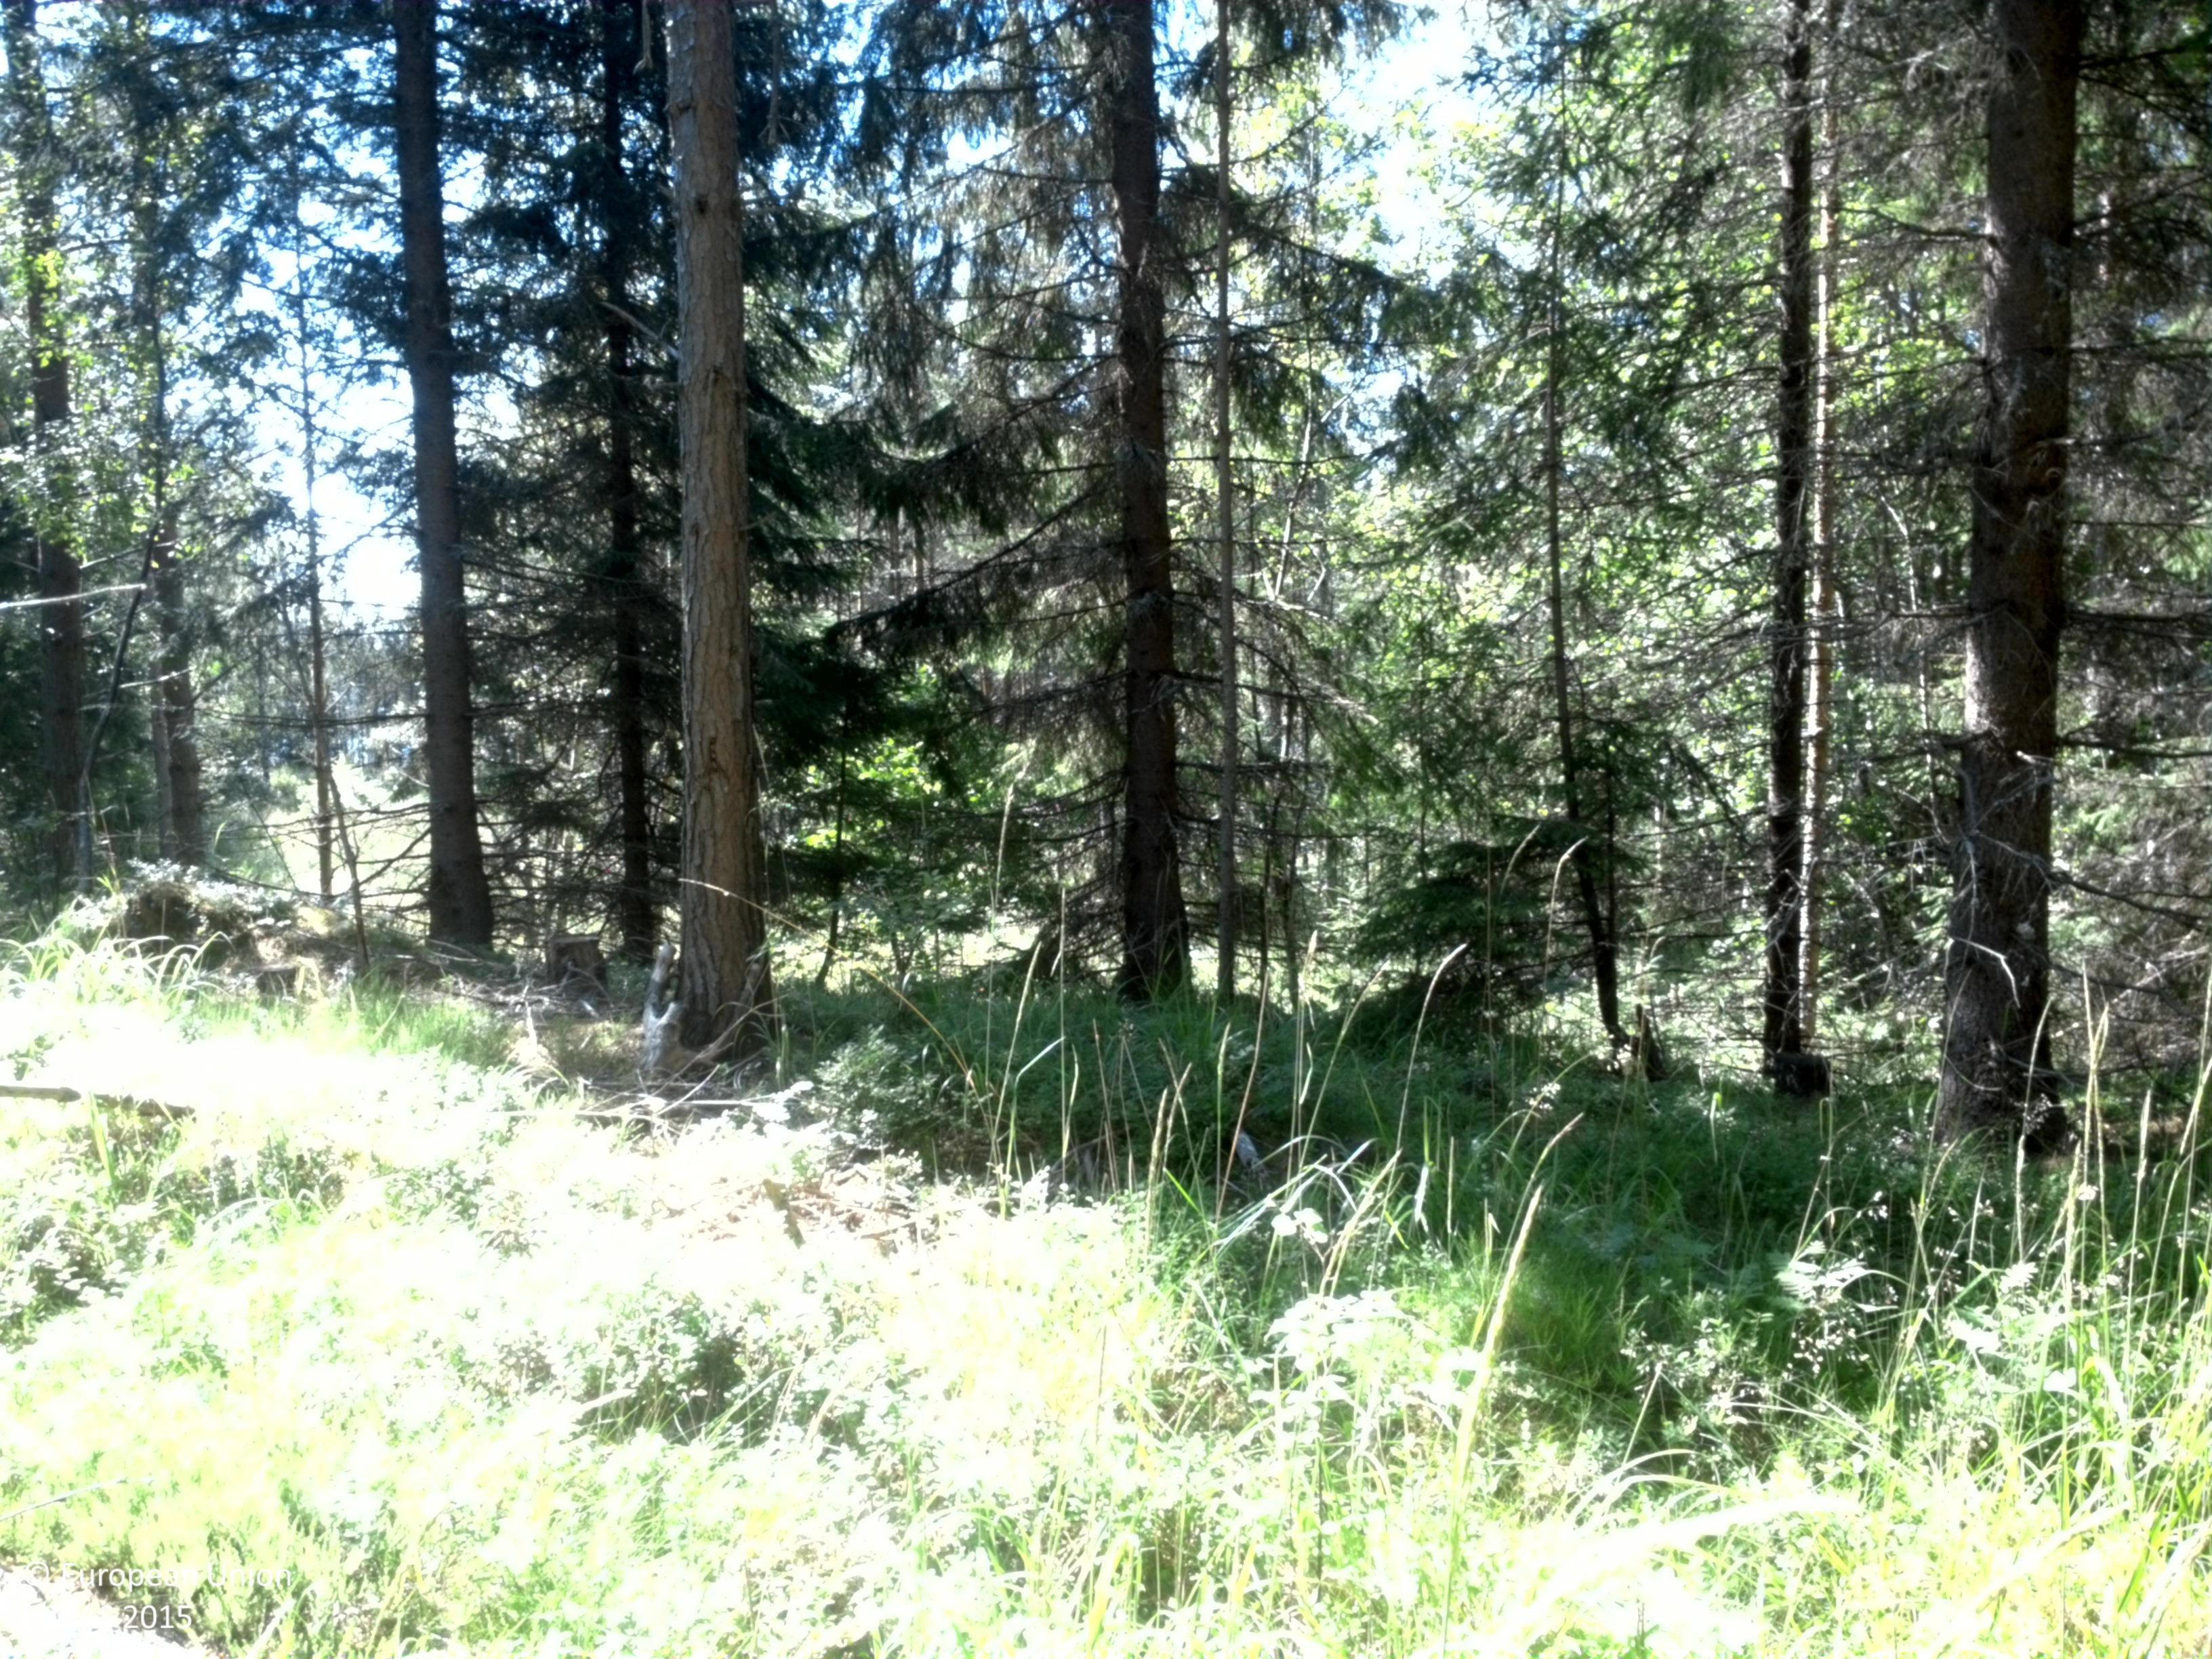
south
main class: Woodland
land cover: Pine dominated coniferous woodland
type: boreal forest
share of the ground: 50 - 75 %
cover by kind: coniferous forest trees 40 %, herbaceous plants 35 %, broadleaved forest trees 10 %, shrubs 10 %, lichens and mosses 5 %
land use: Forestry
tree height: > 5 m
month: July
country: SE
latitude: 59.6518
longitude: 14.6927
